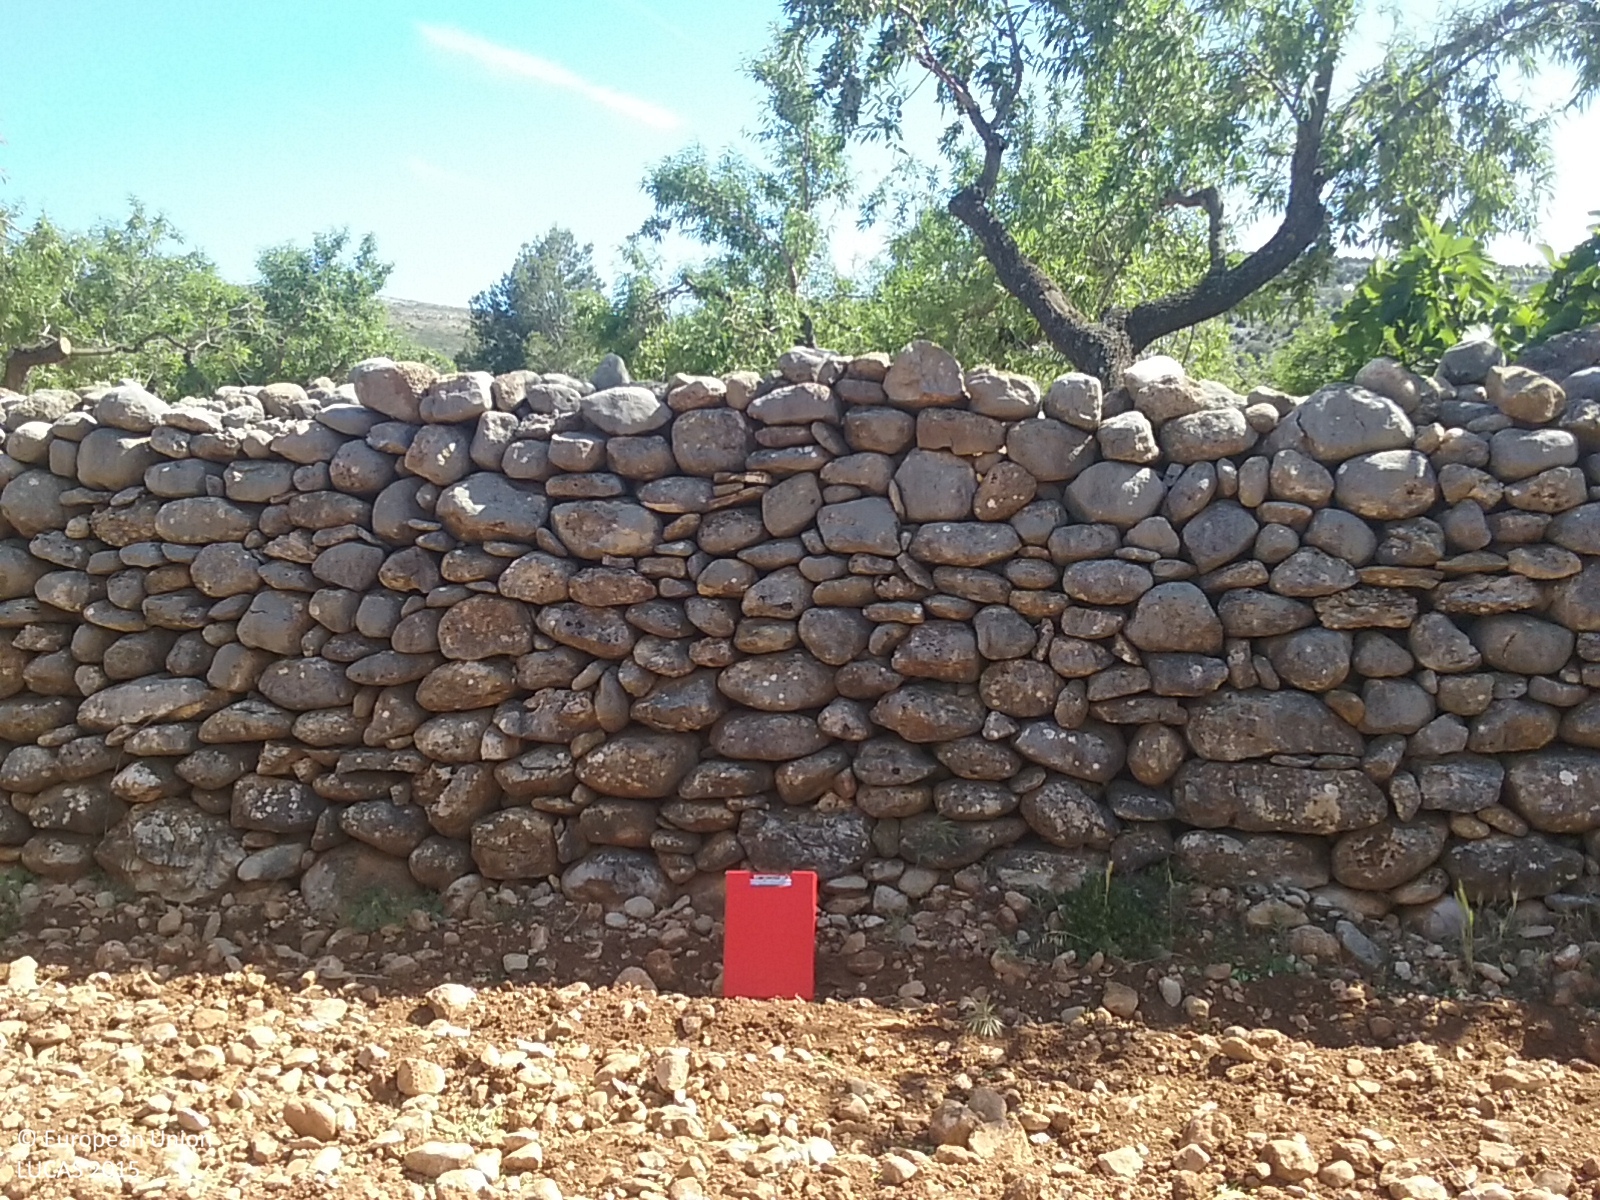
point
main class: Cropland
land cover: Nuts trees
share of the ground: 25 - 50 %
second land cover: Other bare soil
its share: > 75 %
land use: Agriculture (excluding fallow land and kitchen gardens)
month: May
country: ES
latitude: 40.3693
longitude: -0.0505
